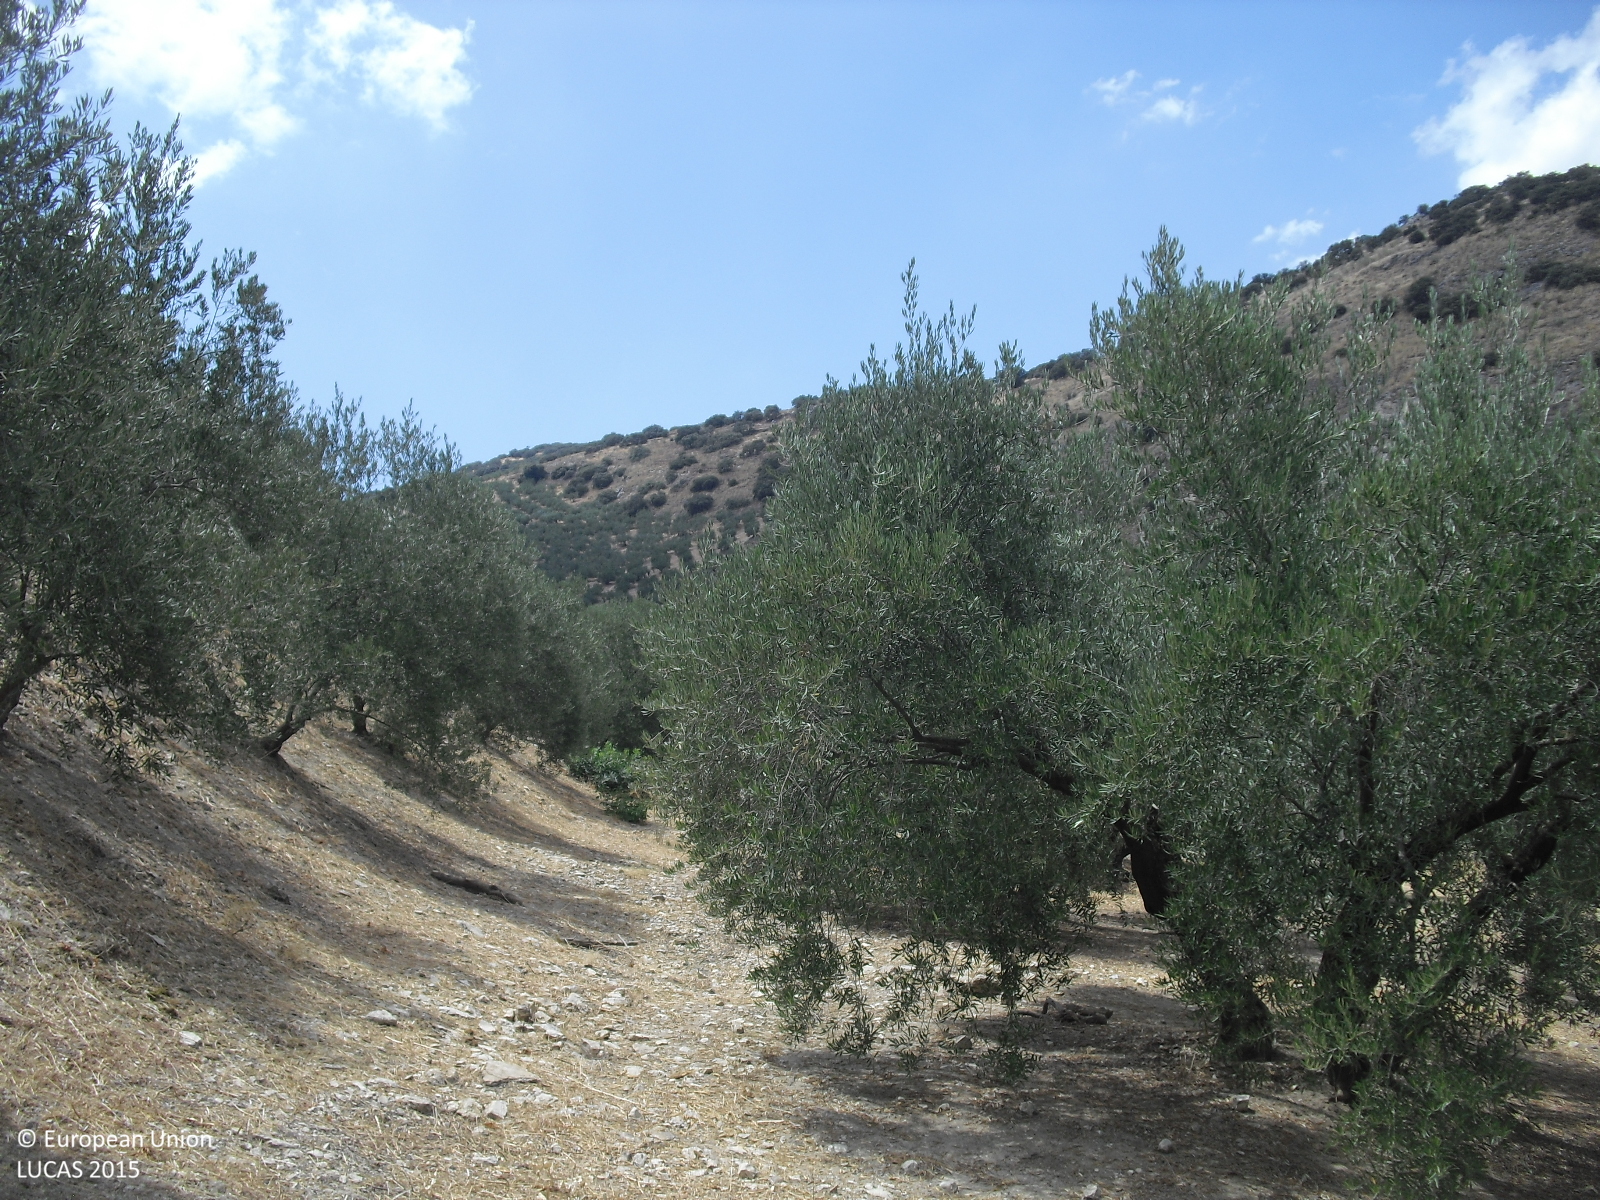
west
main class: Cropland
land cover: Olive groves
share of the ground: 50 - 75 %
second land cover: Other bare soil
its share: > 75 %
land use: Agriculture (excluding fallow land and kitchen gardens)
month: July
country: ES
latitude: 37.4278
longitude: -4.0902
